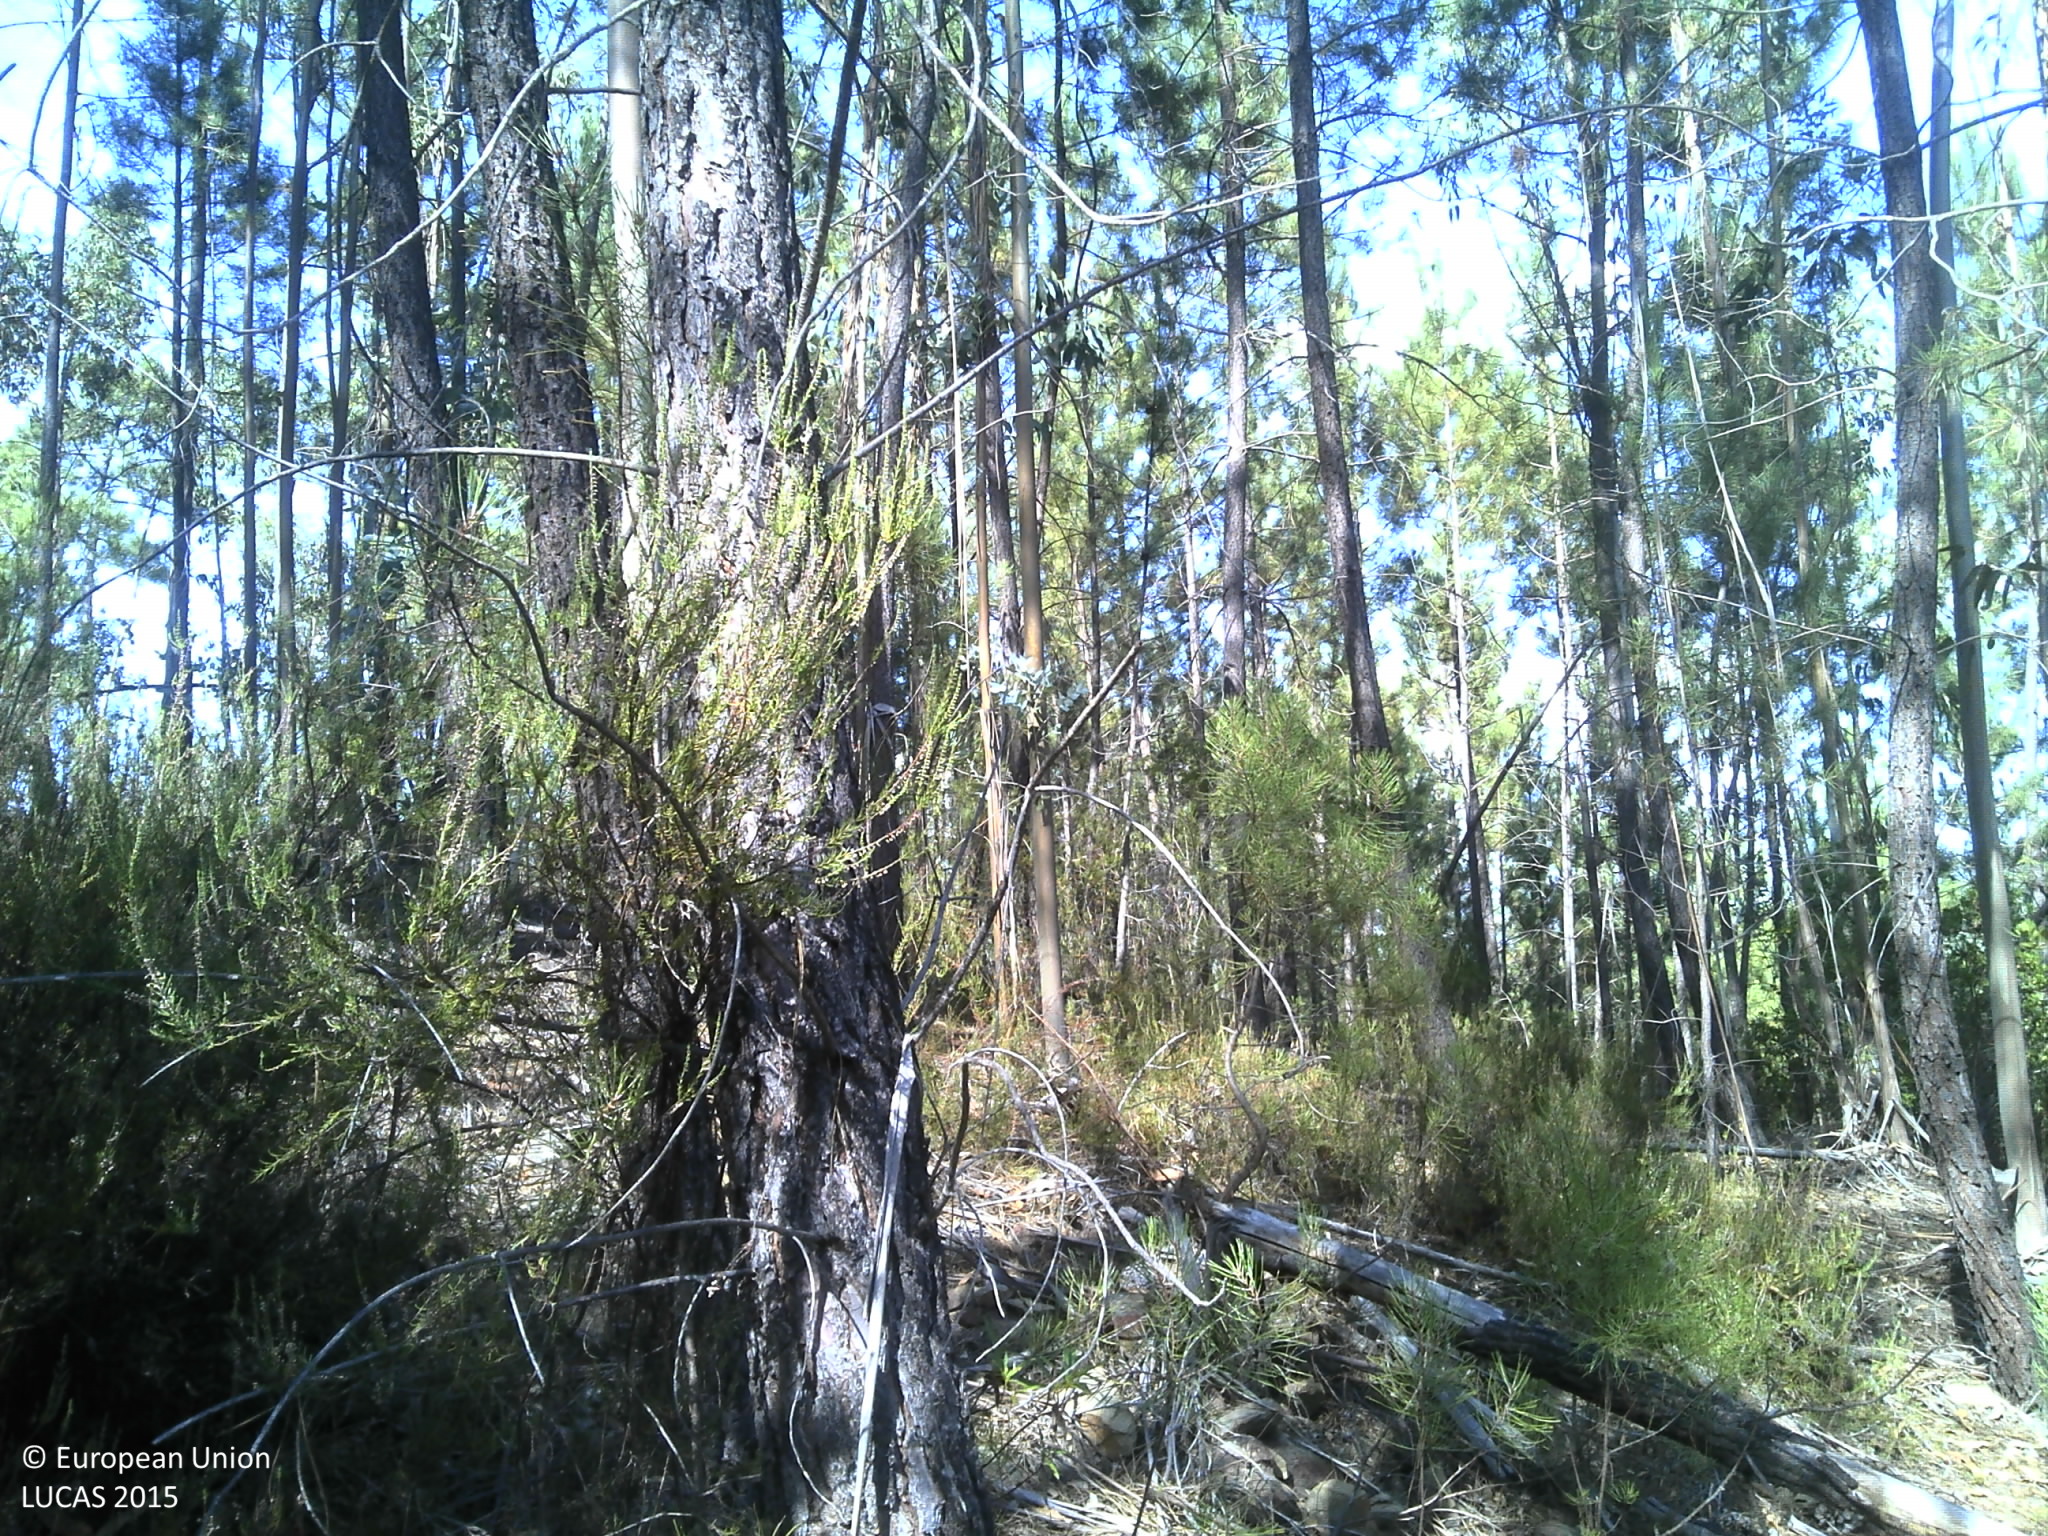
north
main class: Woodland
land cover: Pine dominated coniferous woodland
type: coniferous forest of the mediterranean region
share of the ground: 25 - 50 %
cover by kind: coniferous forest trees 50 %, shrubs 30 %, unconsolidated bare surface 20 %
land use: Forestry
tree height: > 5 m
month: July
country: PT
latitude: 39.9996
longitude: -7.8568
